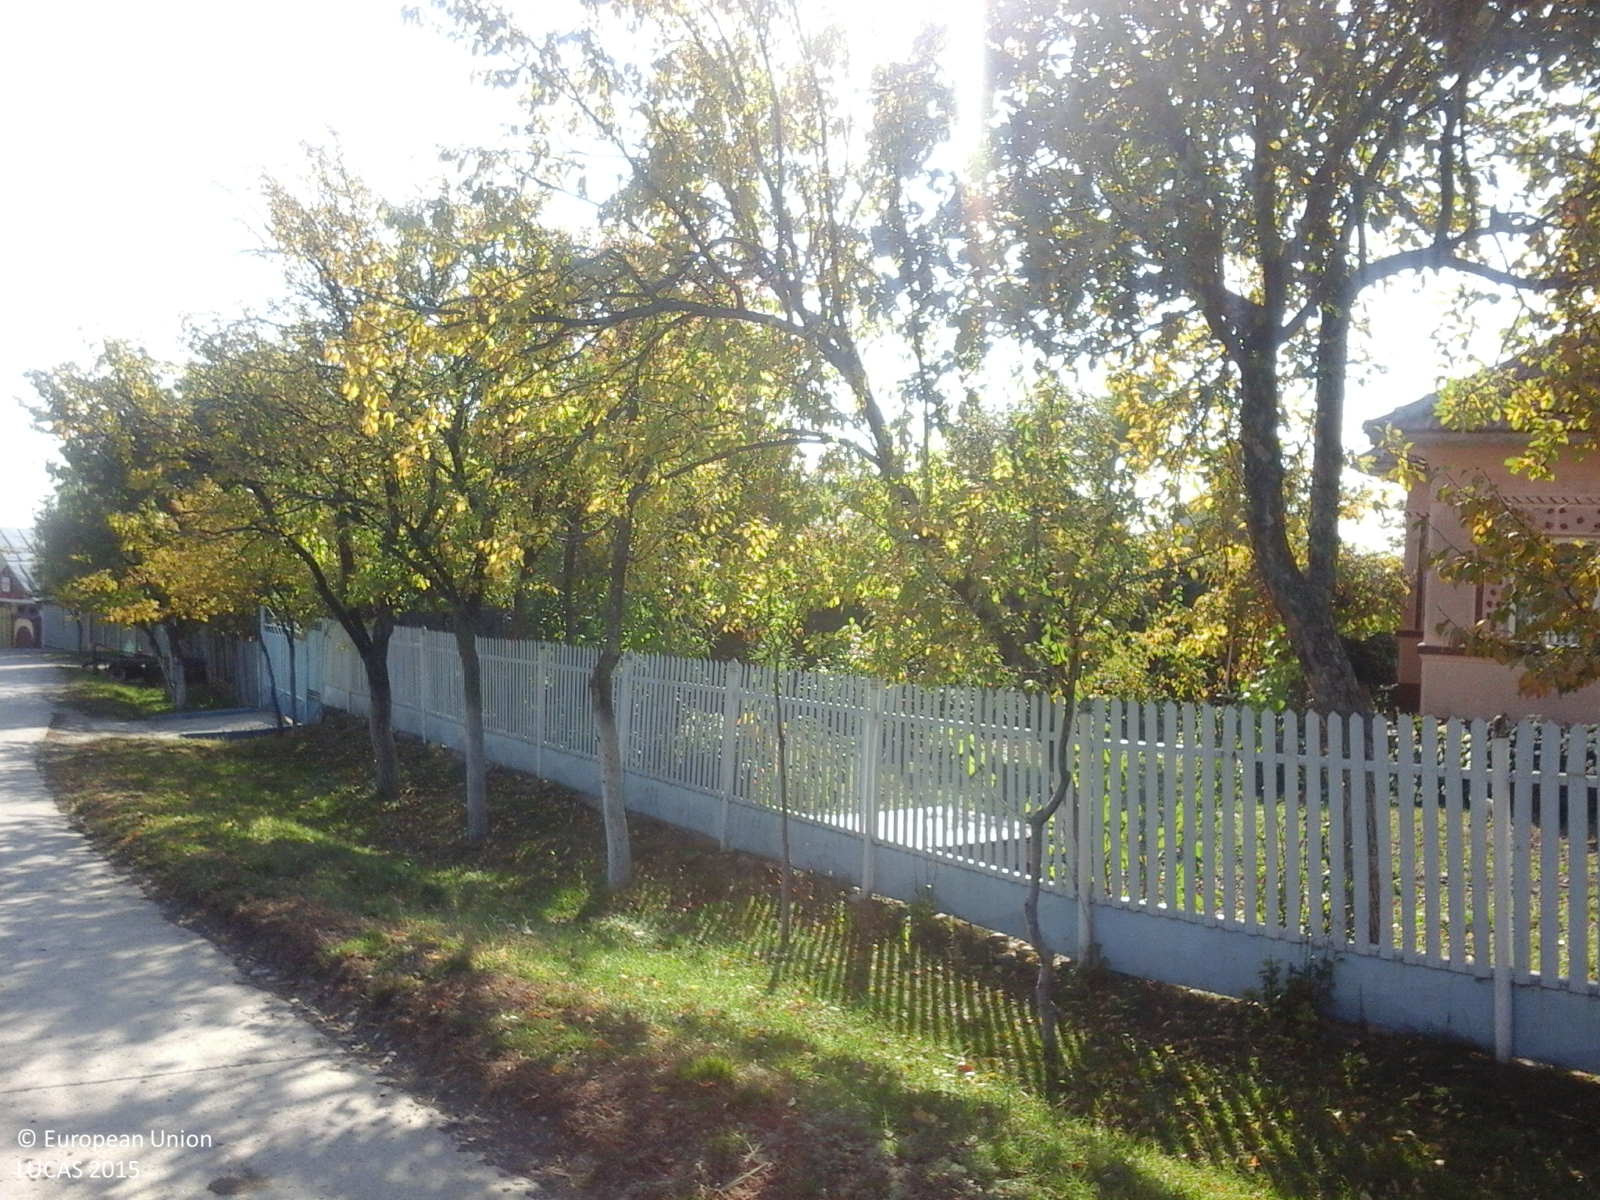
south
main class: Grassland
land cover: Grassland without tree/shrub cover
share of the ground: > 75 %
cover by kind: herbaceous plants 100 %
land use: Agriculture (excluding fallow land and kitchen gardens)
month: October
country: RO
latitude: 45.2827
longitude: 26.8201
